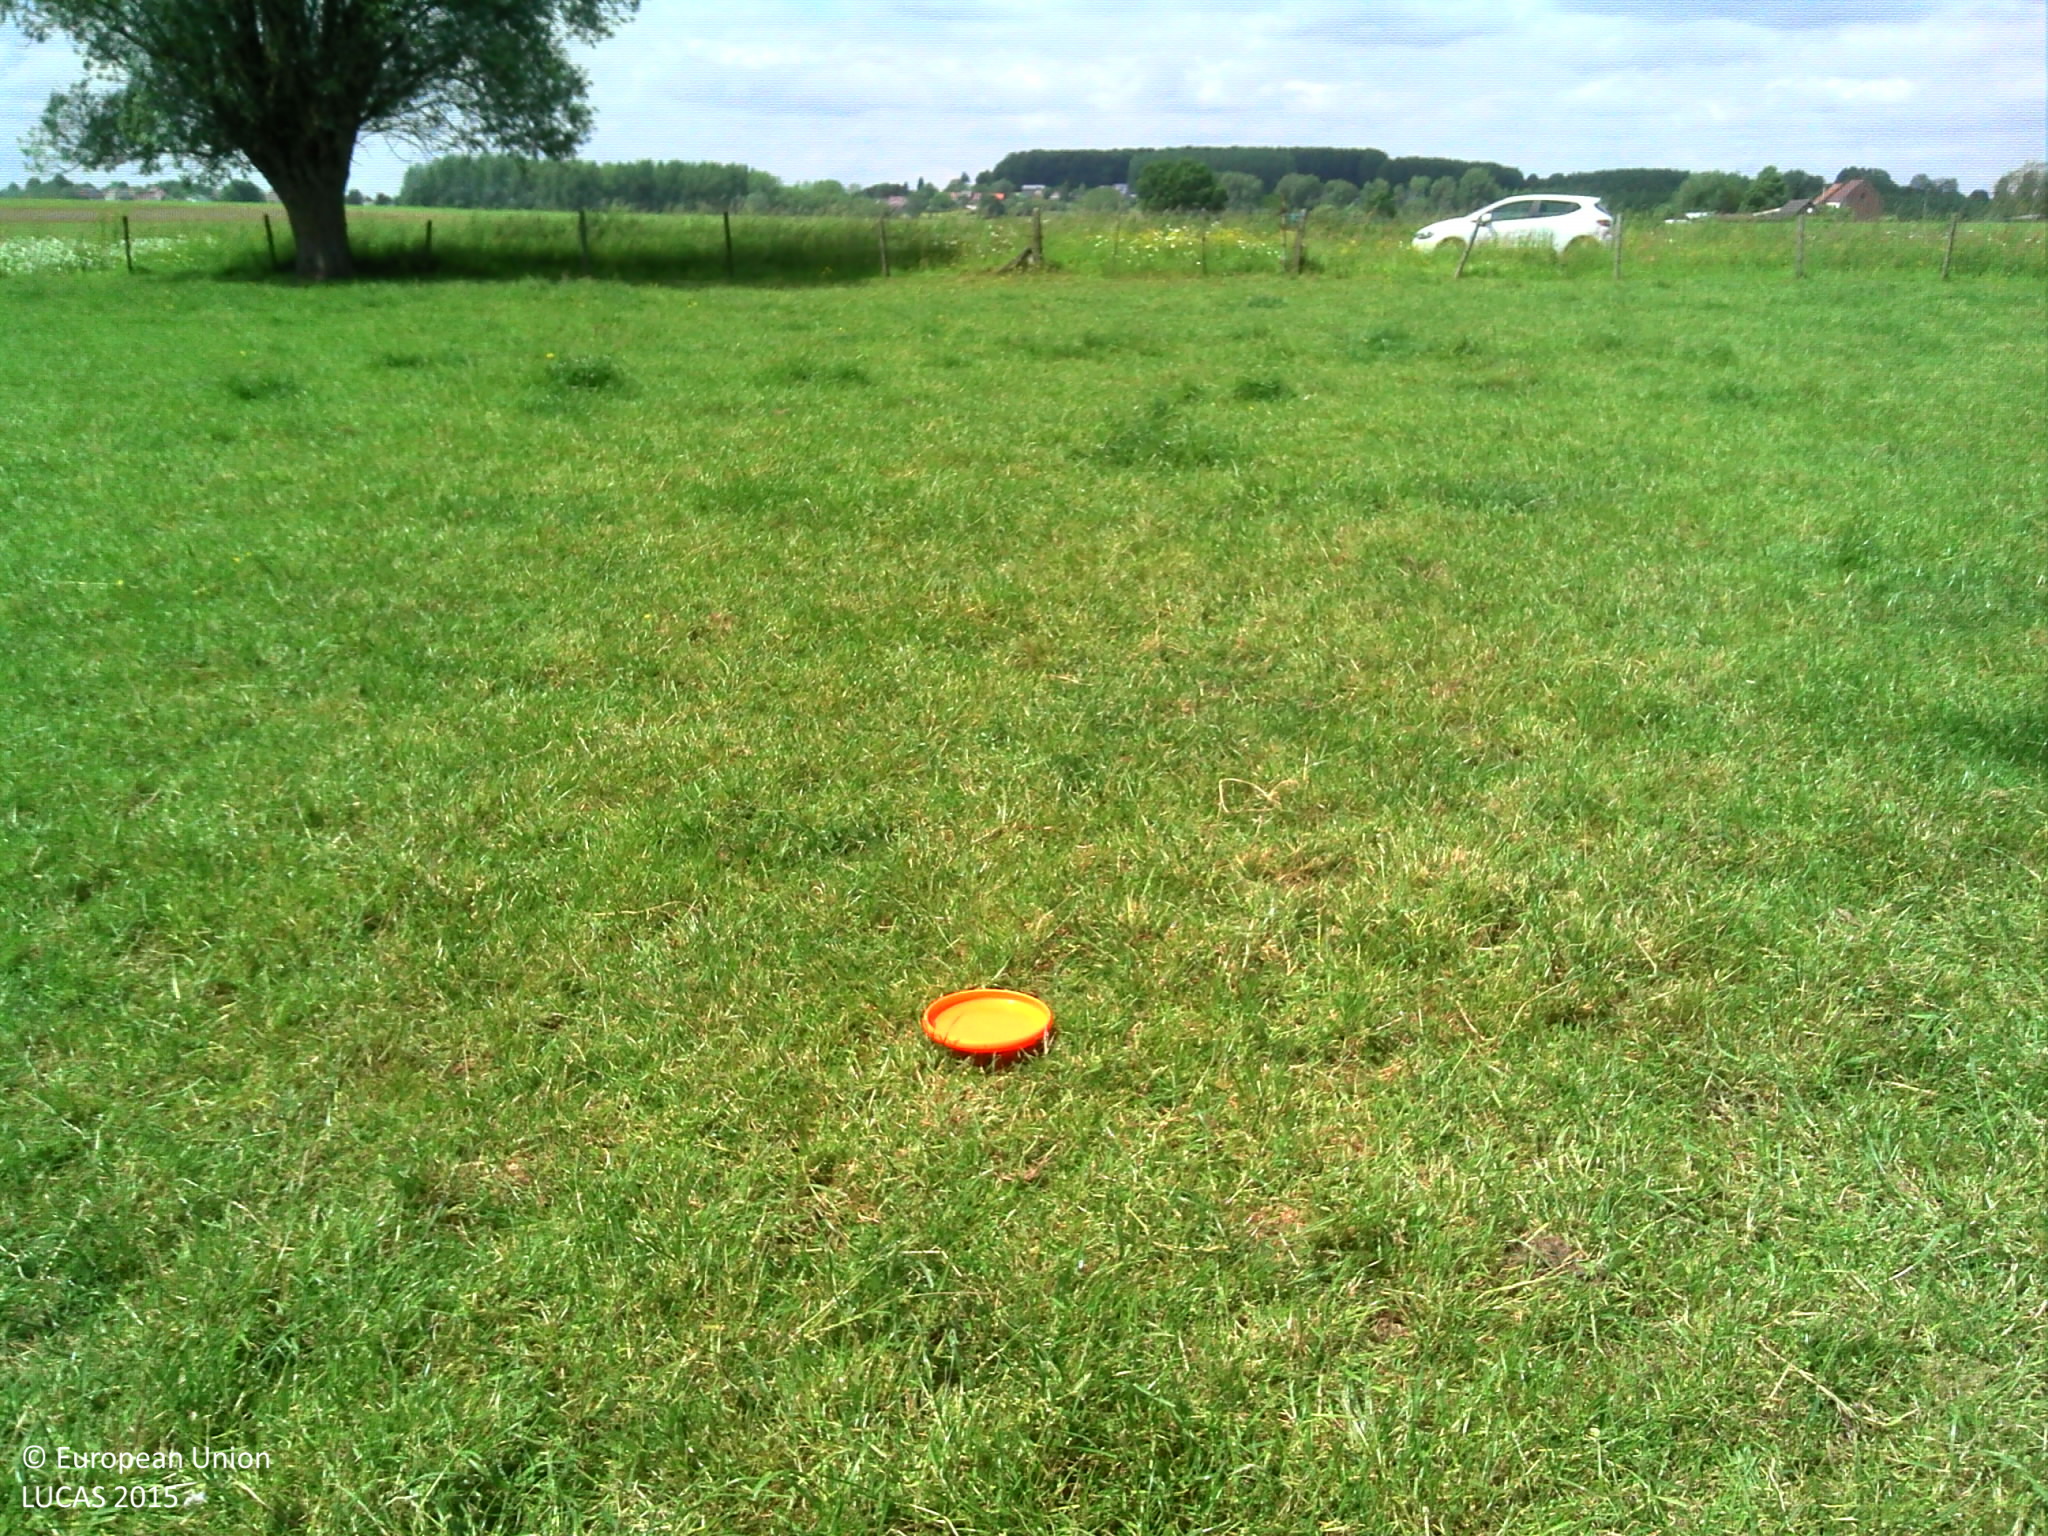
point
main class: Grassland
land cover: Grassland without tree/shrub cover
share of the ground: > 75 %
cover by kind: herbaceous plants 100 %
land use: Agriculture (excluding fallow land and kitchen gardens)
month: June
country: BE
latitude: 50.7907
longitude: 3.7942
